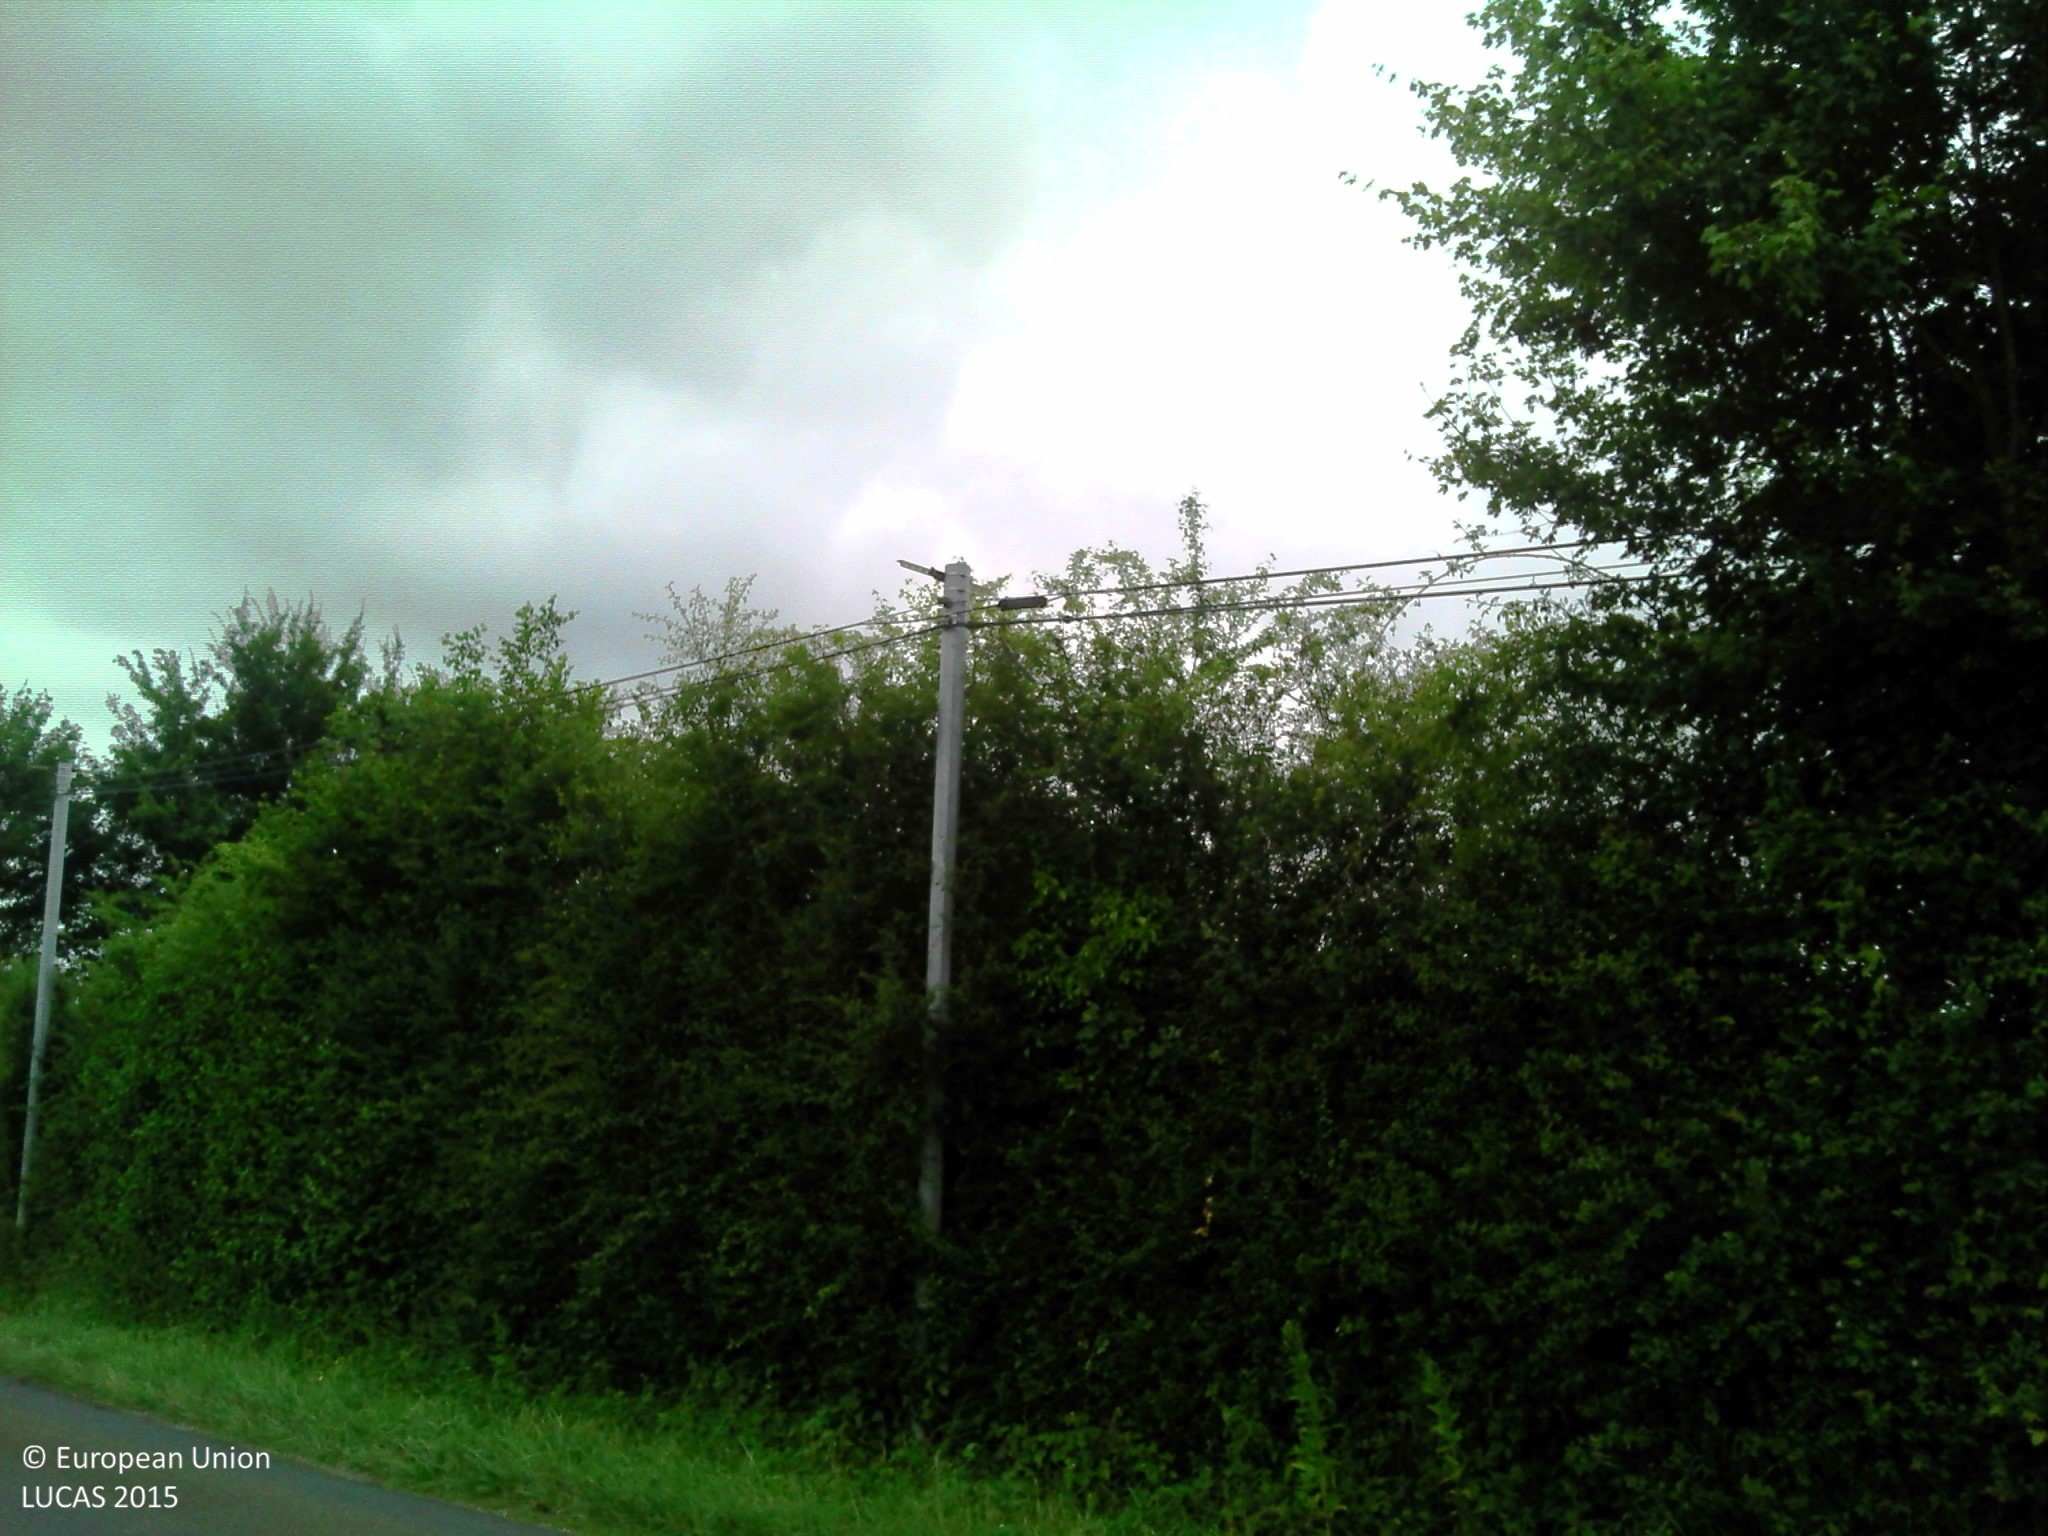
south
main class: Grassland
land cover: Grassland without tree/shrub cover
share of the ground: > 75 %
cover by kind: herbaceous plants 100 %
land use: Agriculture (excluding fallow land and kitchen gardens)
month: June
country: FR
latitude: 48.0844
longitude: 0.2955
